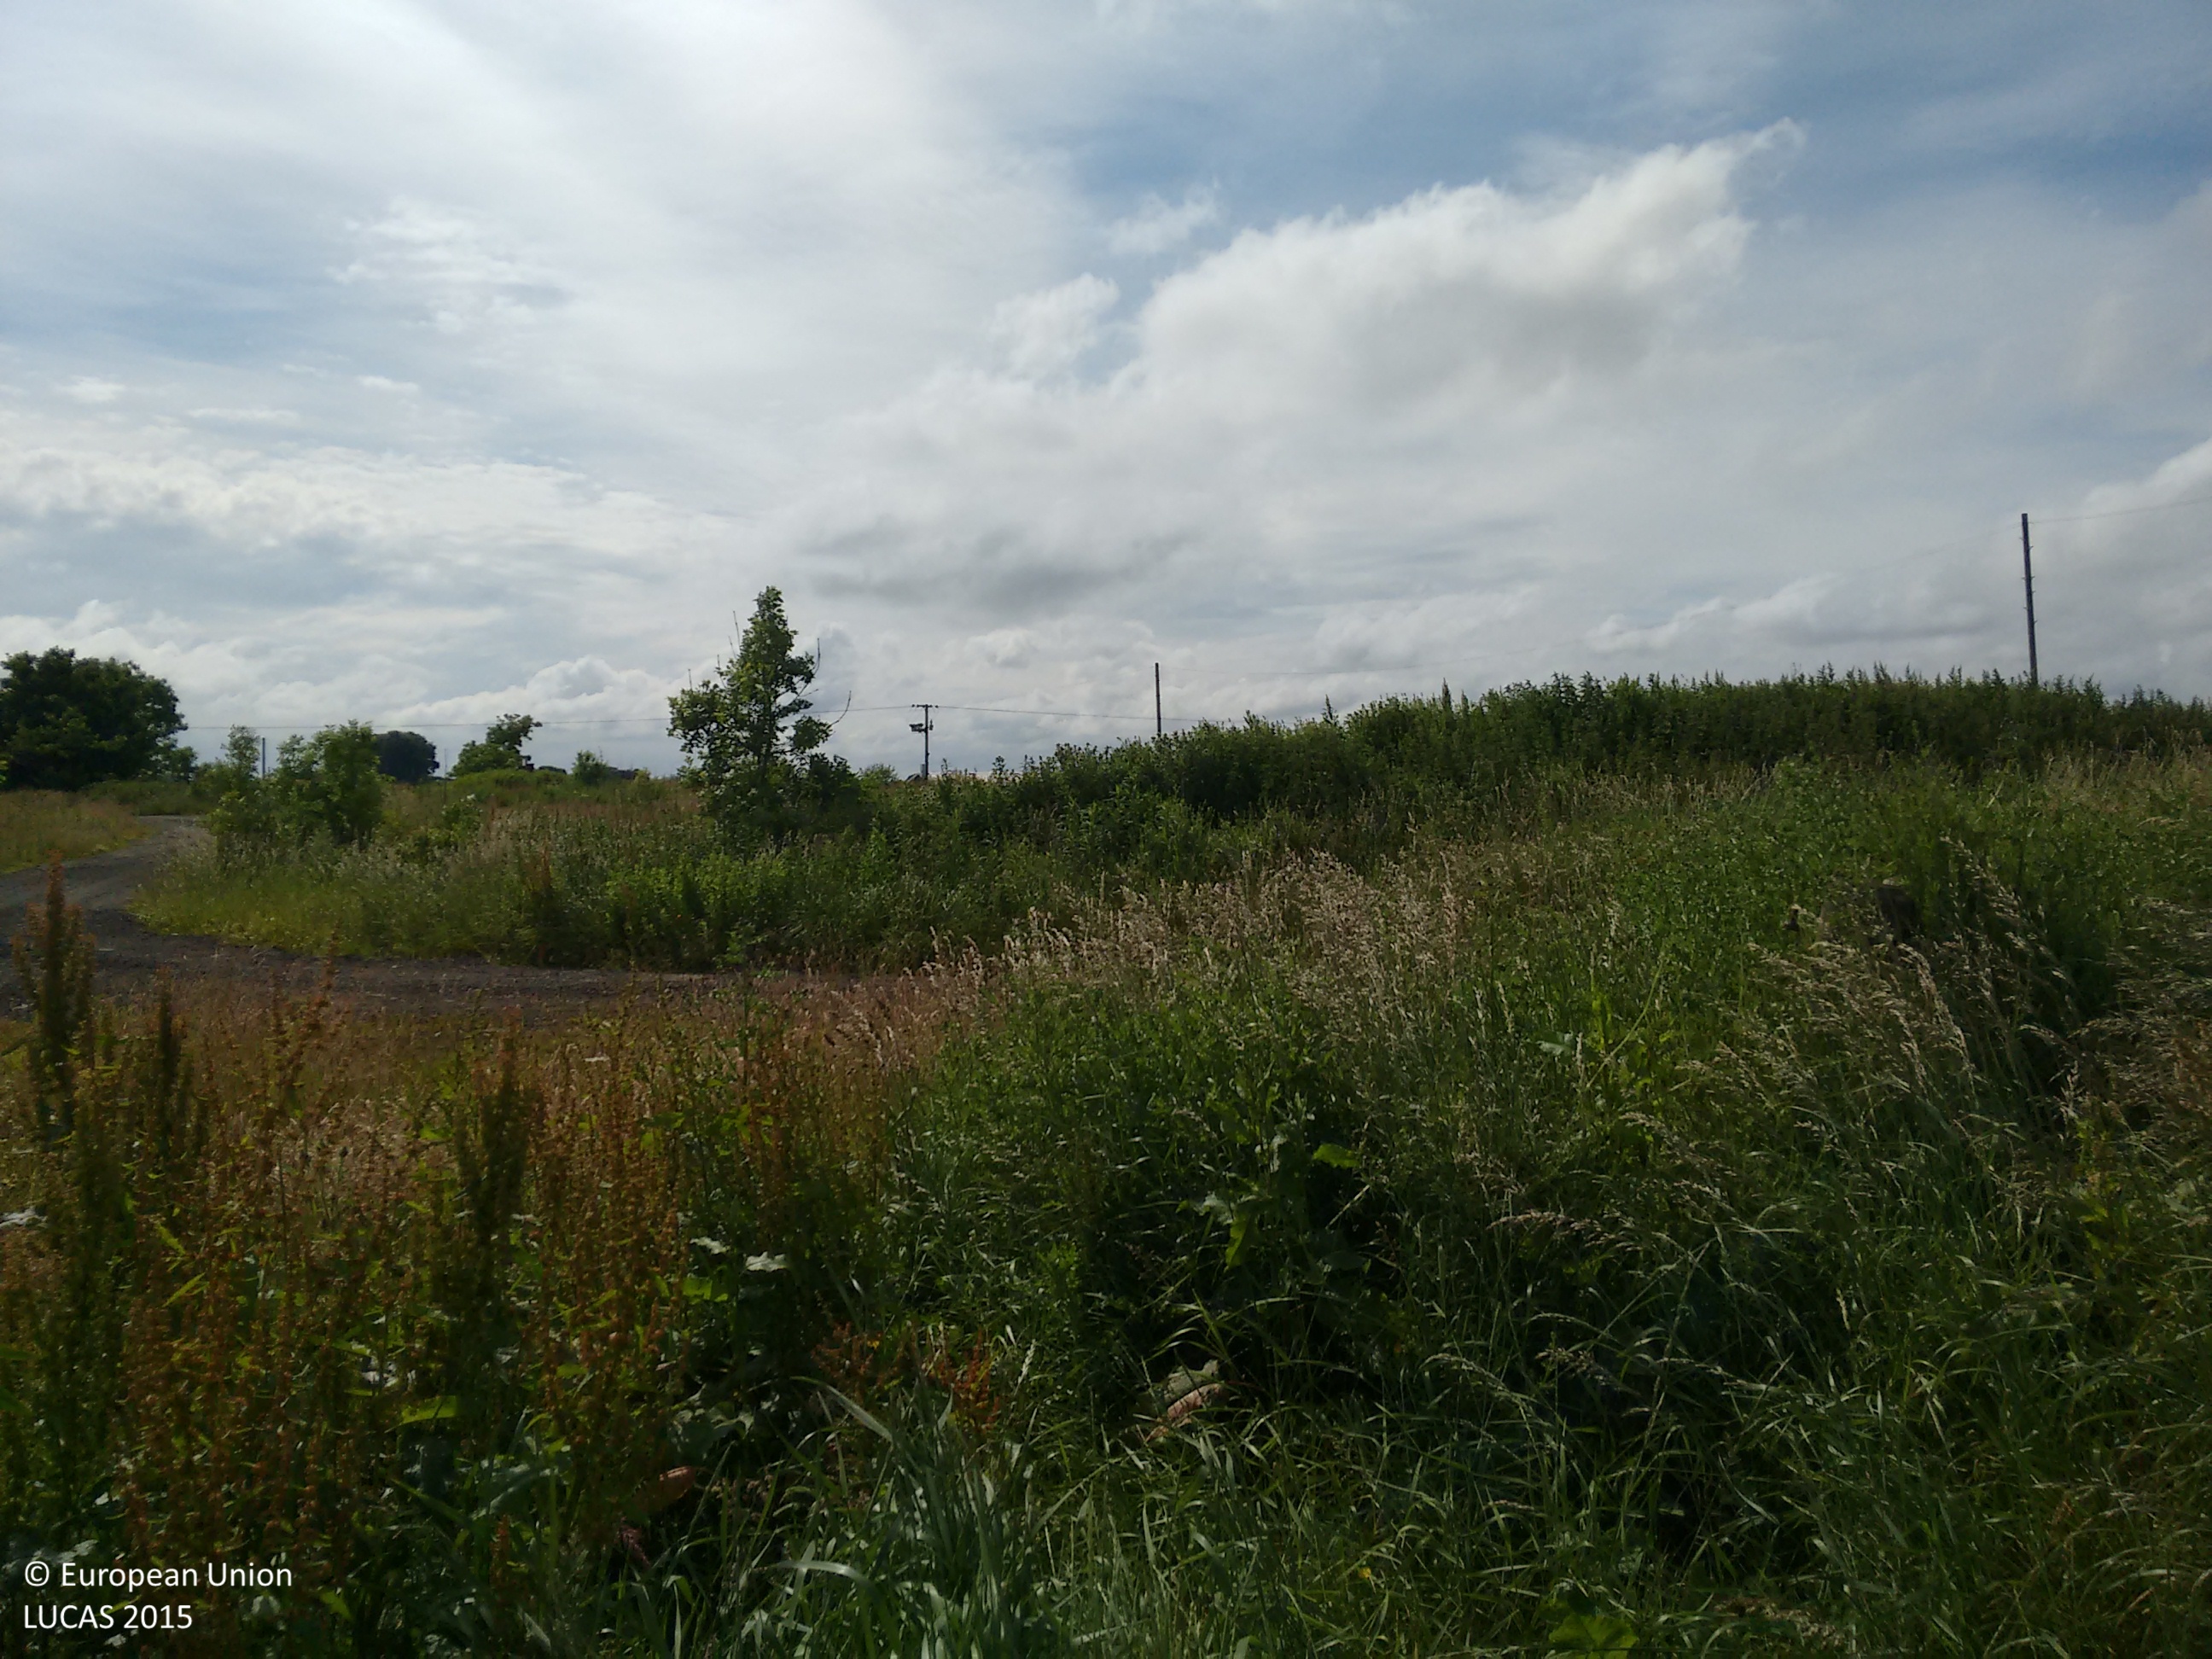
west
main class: Cropland
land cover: Barley
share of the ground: > 75 %
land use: Agriculture (excluding fallow land and kitchen gardens)
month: July
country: GB
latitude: 56.1044
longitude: -3.3709
